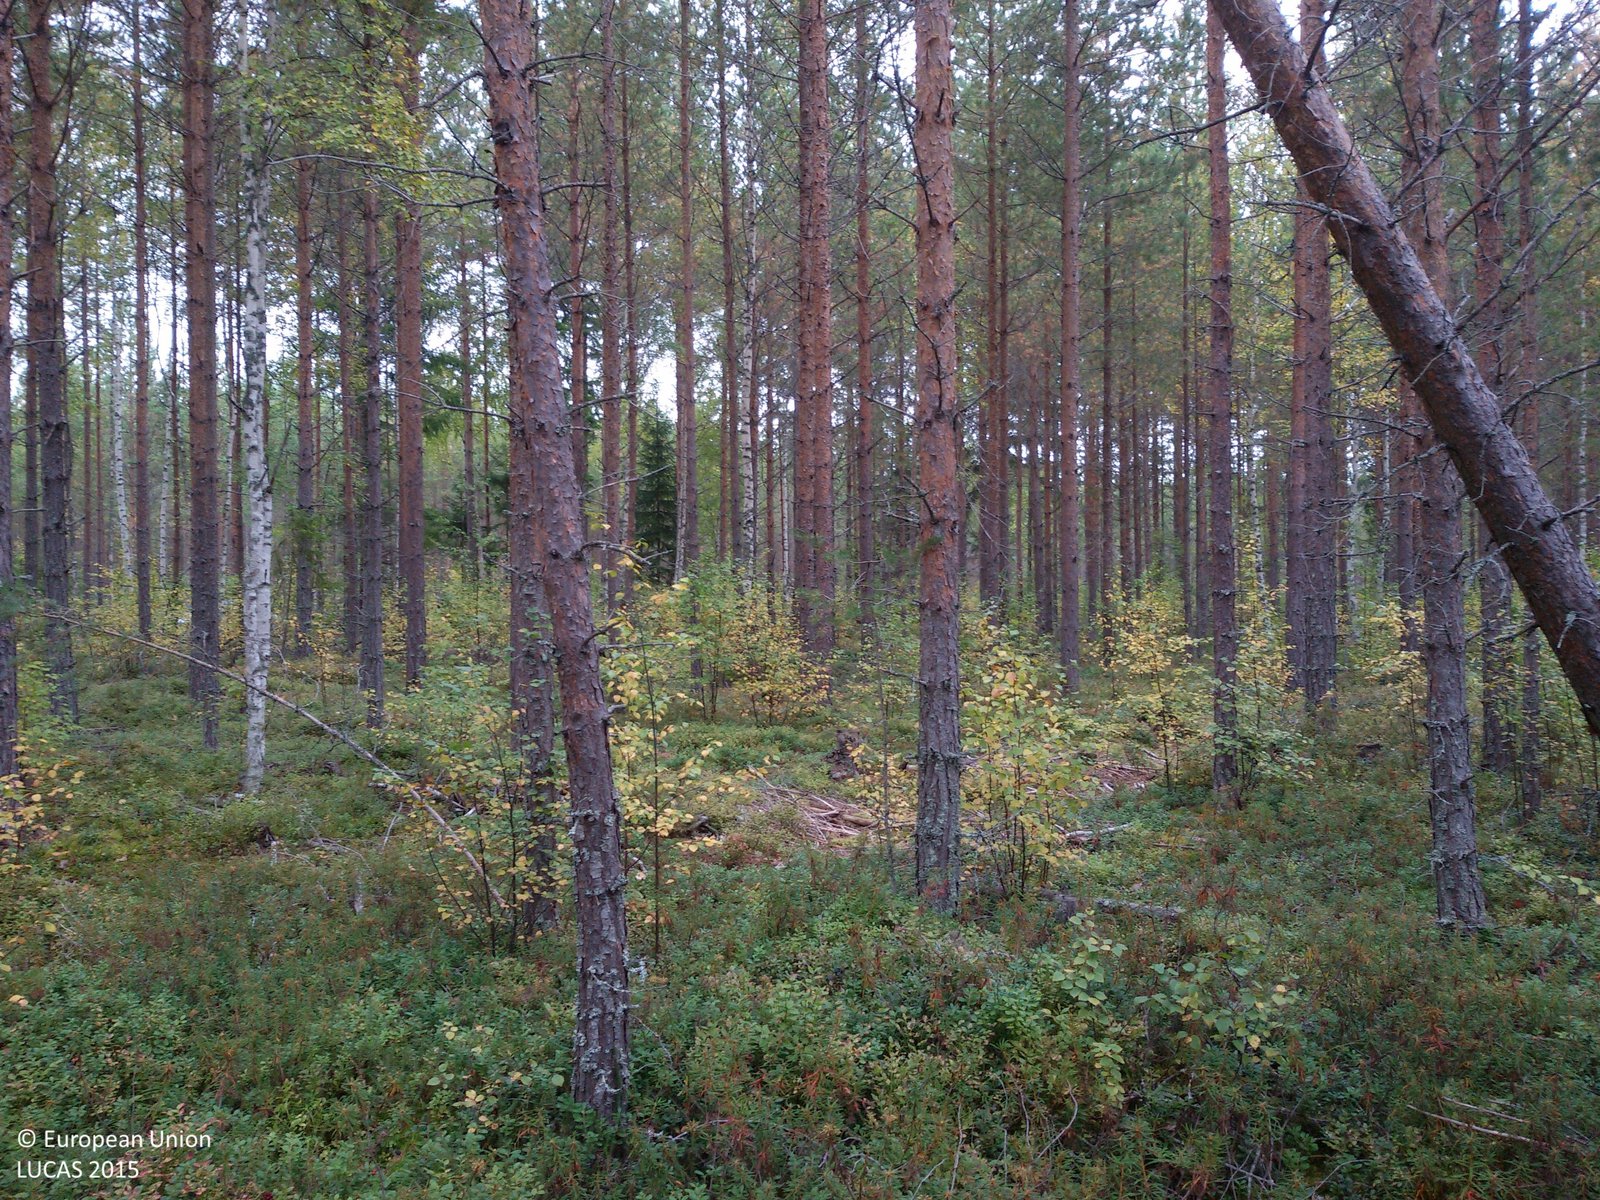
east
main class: Woodland
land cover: Pine dominated coniferous woodland
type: boreal forest
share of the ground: > 75 %
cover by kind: coniferous forest trees 75 %, shrubs 15 %, lichens and mosses 10 %
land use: Forestry
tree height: > 5 m
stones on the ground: 10 - 25 %
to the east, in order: Pine dominated coniferous woodland; Paved roads, cycling and walking lanes; Ditches and canals; Pine dominated coniferous woodland
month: September
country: SE
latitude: 60.8020
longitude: 14.8200
